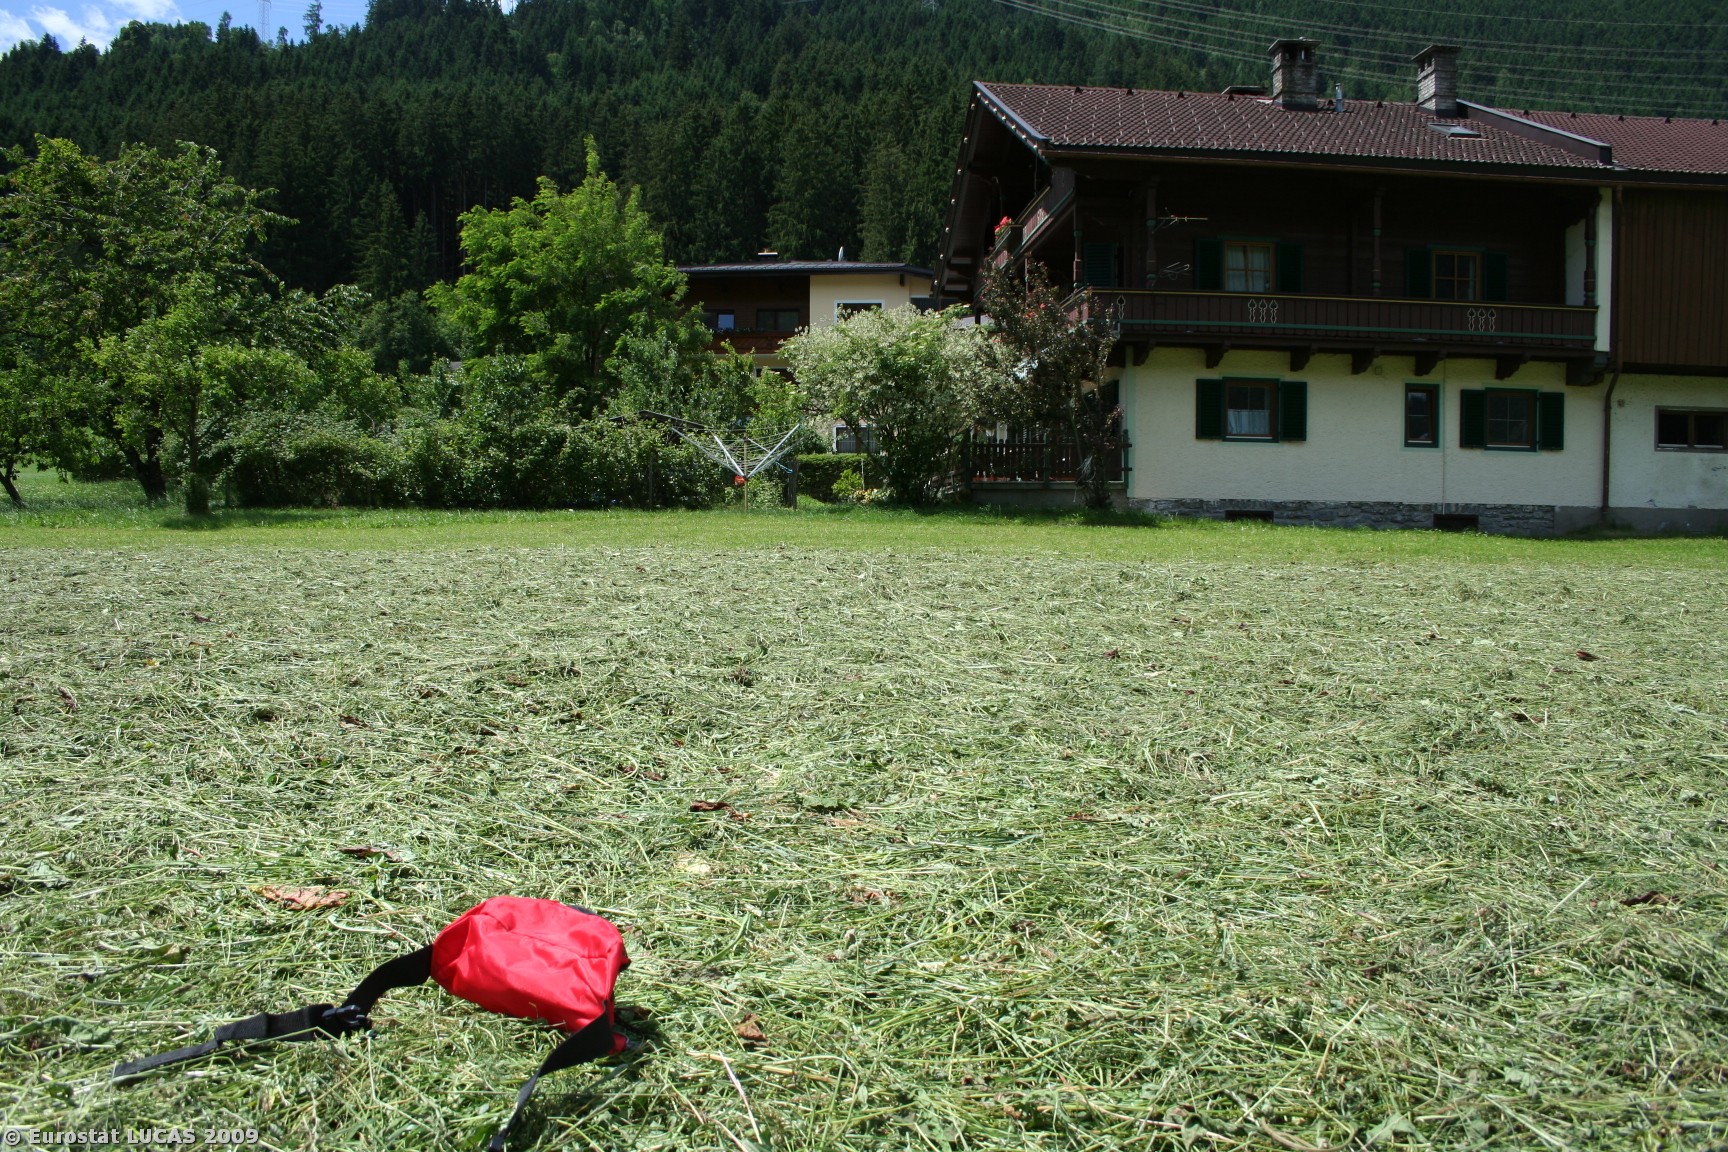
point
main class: Grassland
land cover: Grassland without tree/shrub cover
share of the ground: > 75 %
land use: Agriculture (excluding fallow land and kitchen gardens)
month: June
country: AT
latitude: 47.3076
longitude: 11.8635
